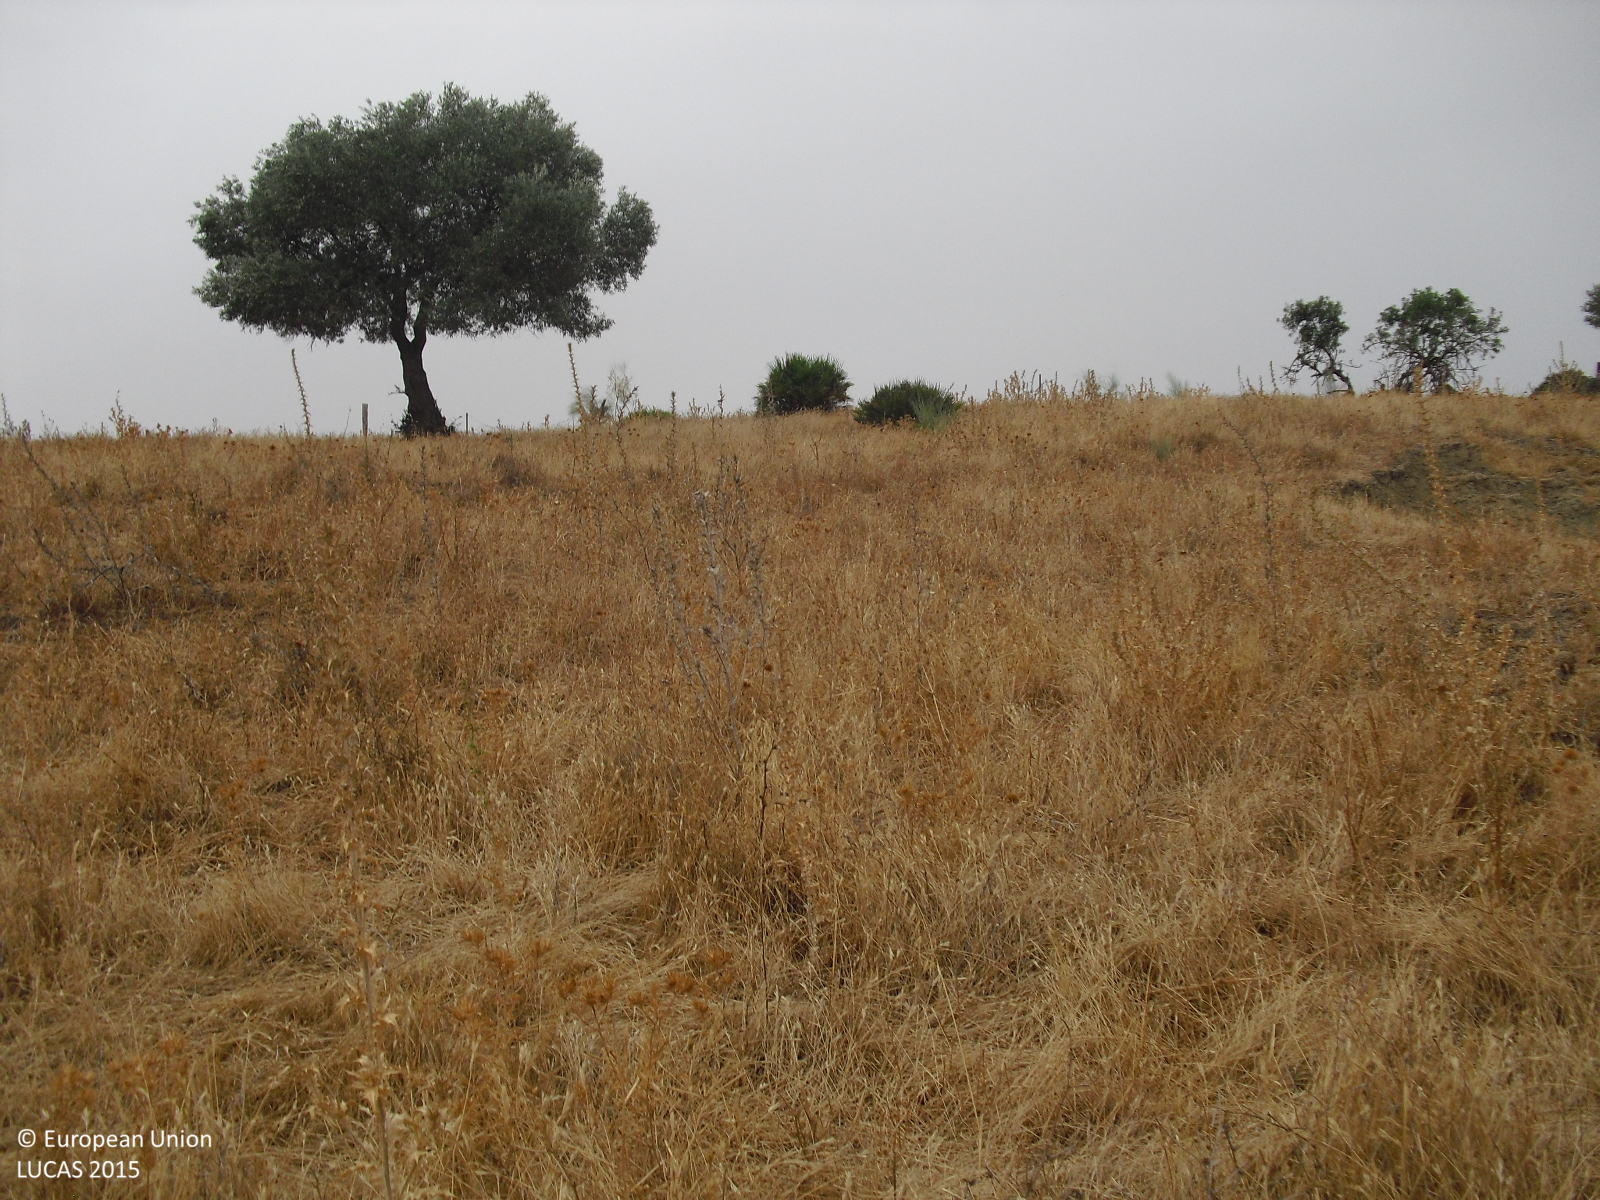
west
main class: Grassland
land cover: Grassland without tree/shrub cover
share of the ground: > 75 %
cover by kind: herbaceous plants 95 %, unconsolidated bare surface 5 %
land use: Agriculture (excluding fallow land and kitchen gardens)
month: August
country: ES
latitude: 37.1410
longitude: -5.3308
